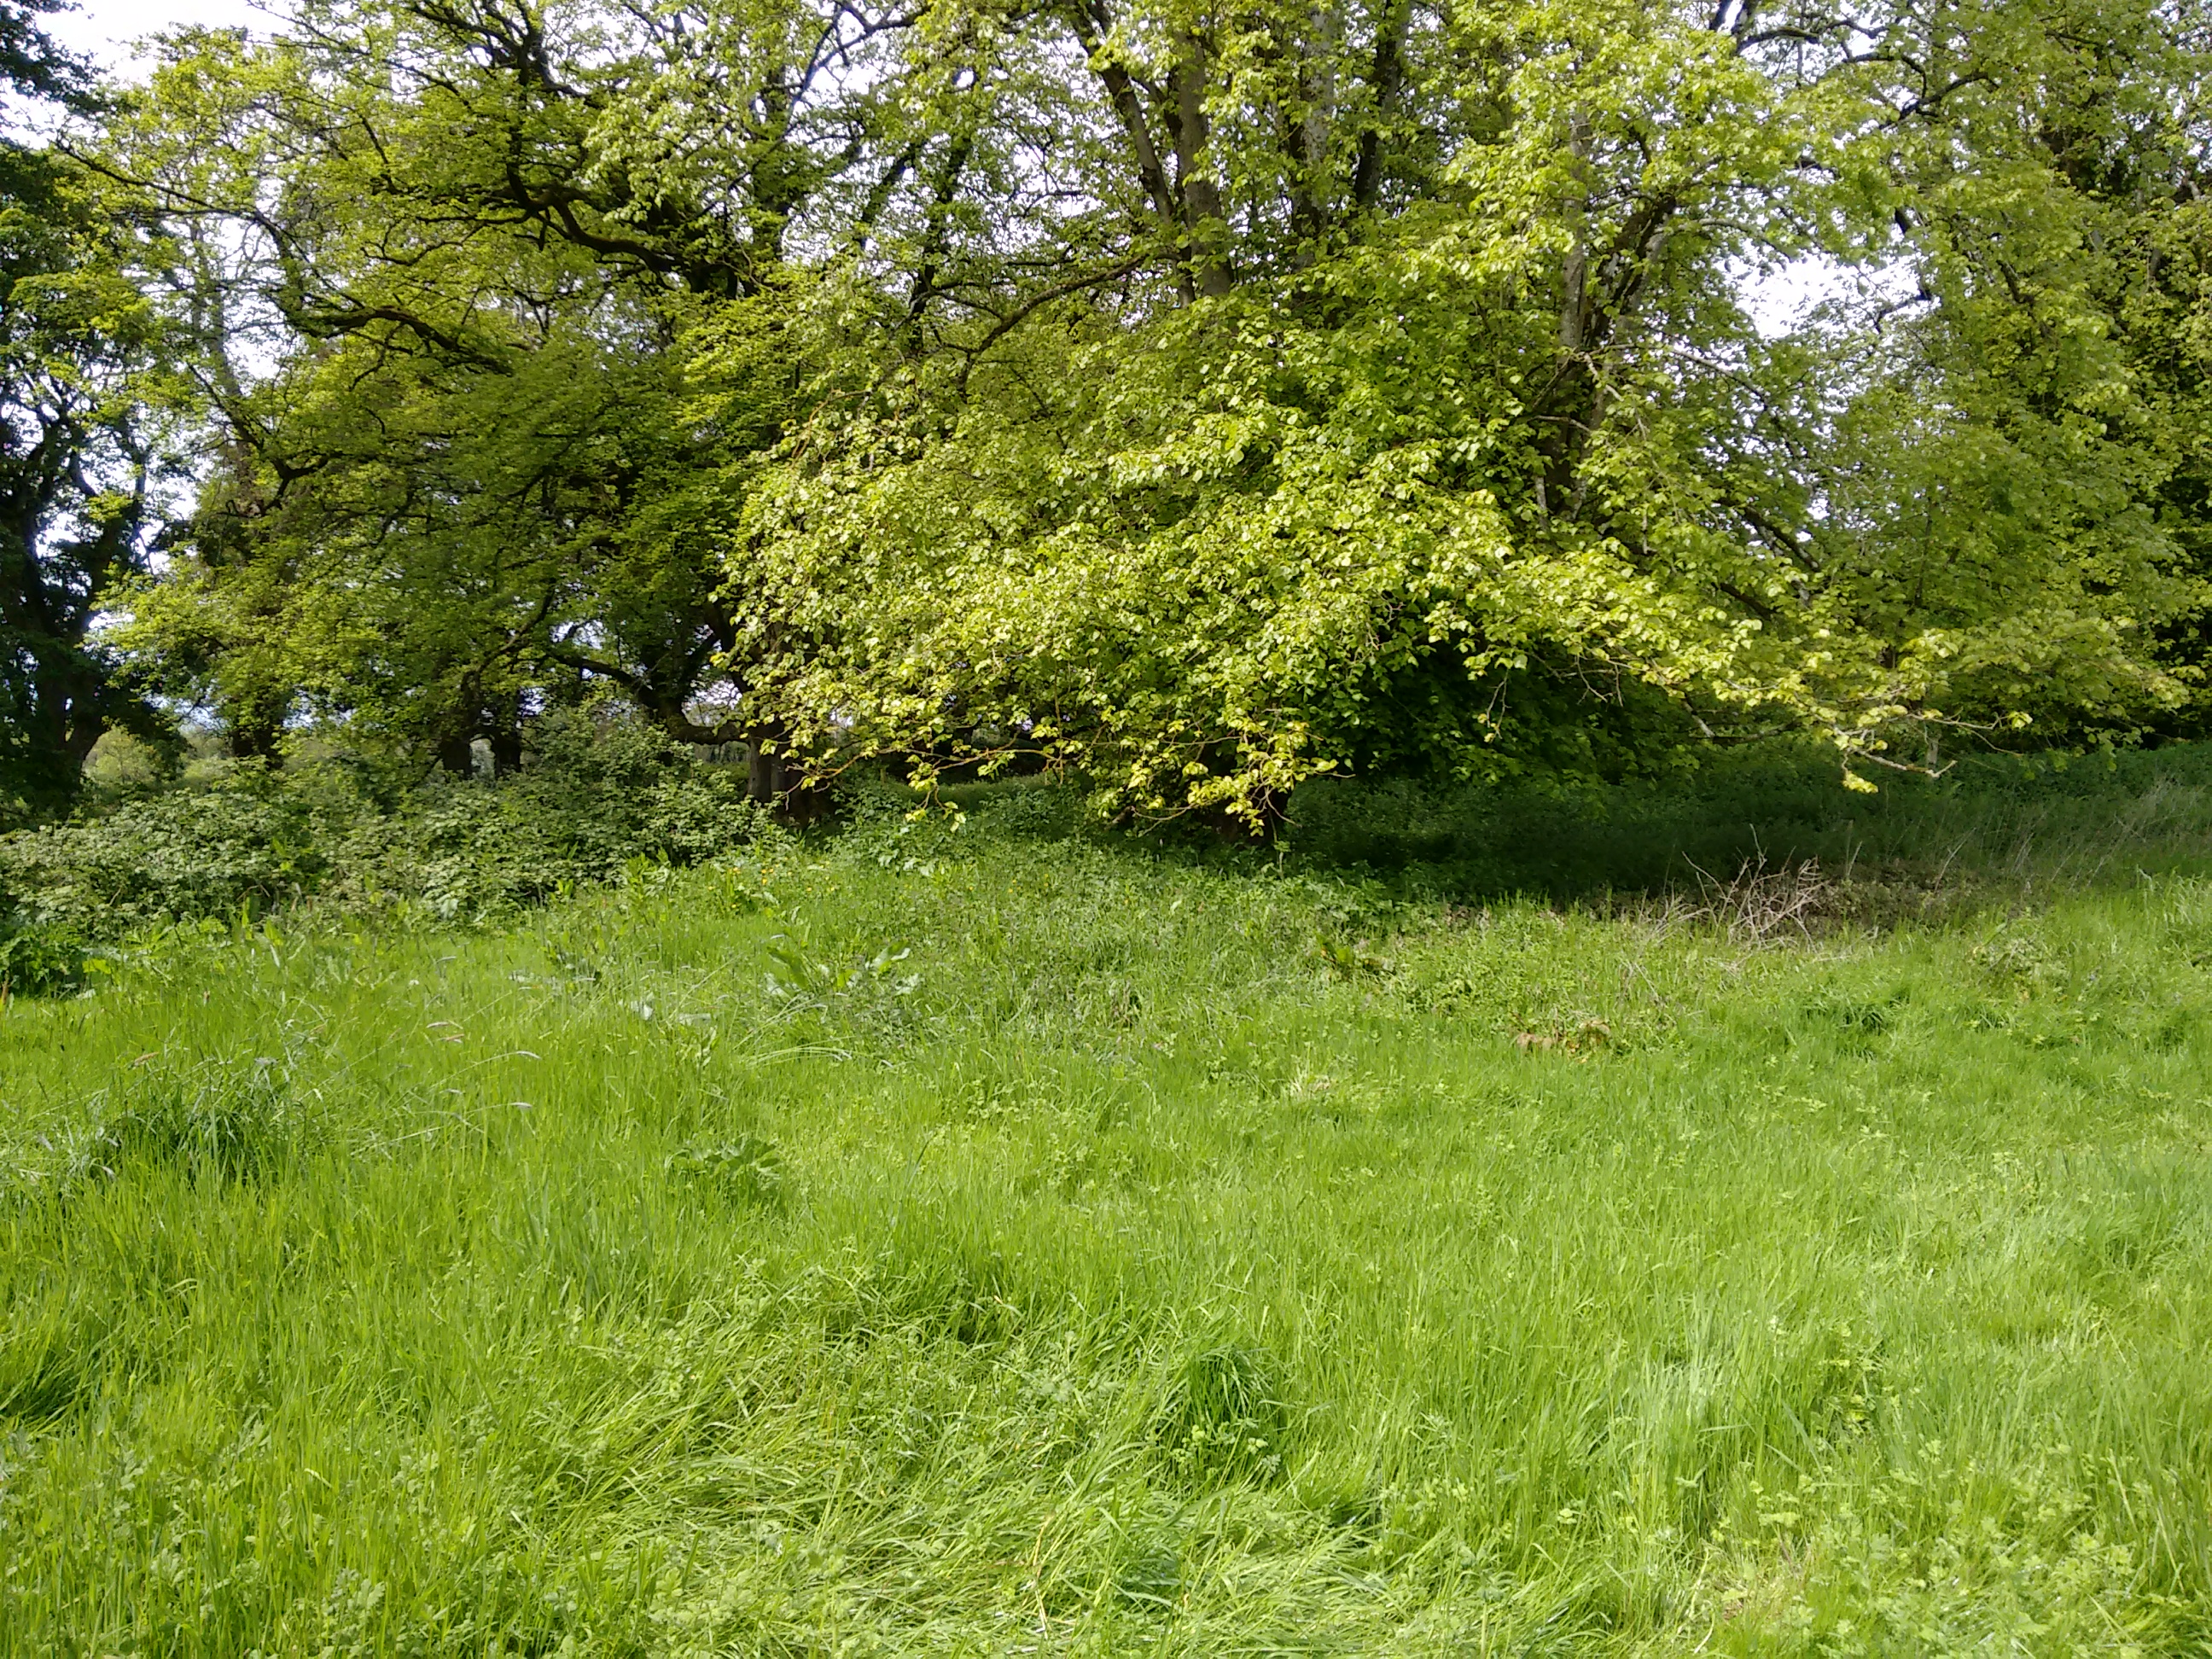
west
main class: Grassland
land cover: Grassland with sparse tree/shrub cover
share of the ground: > 75 %
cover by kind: herbaceous plants 90 %, broadleaved forest trees 5 %, shrubs 5 %
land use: Agriculture (excluding fallow land and kitchen gardens)
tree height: > 5 m
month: May
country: IE
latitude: 53.6125
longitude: -6.8081
